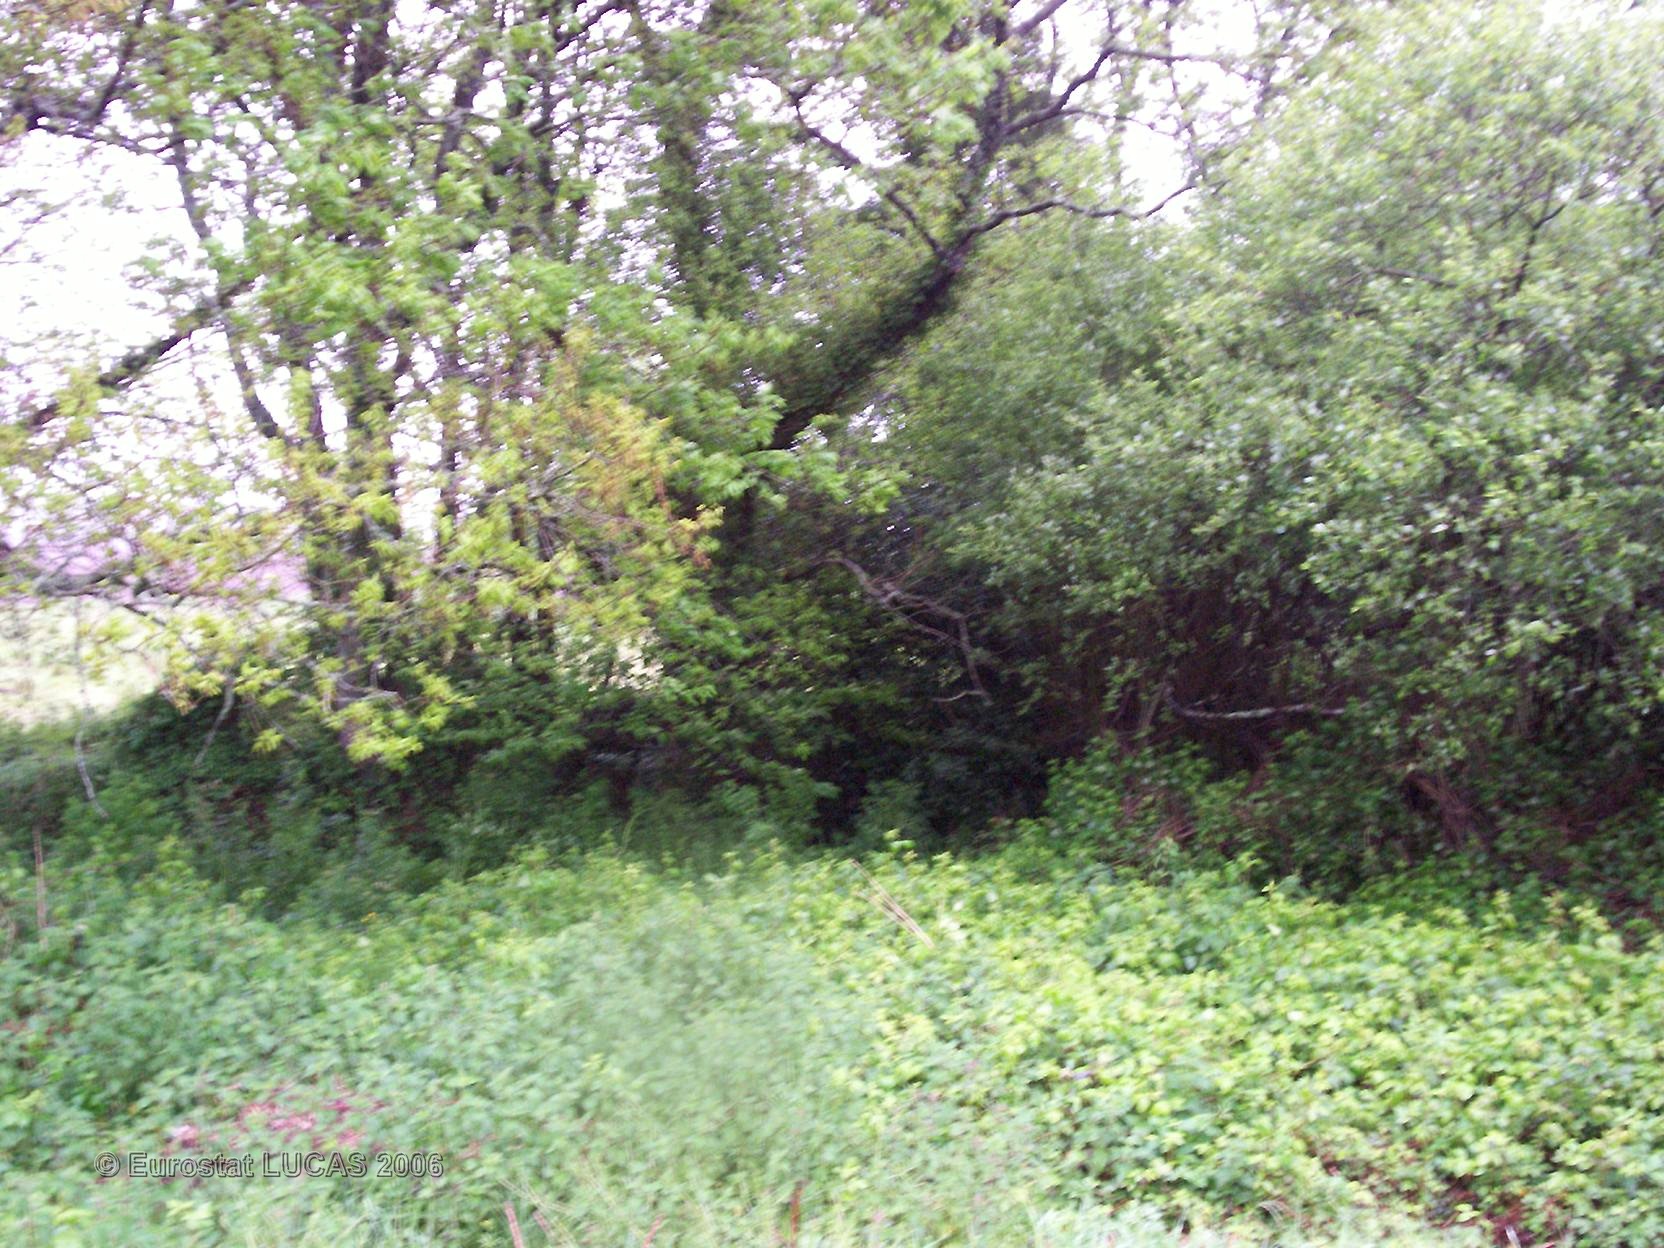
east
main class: Cropland
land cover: Maize
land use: Agriculture (excluding fallow land and kitchen gardens)
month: May
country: FR
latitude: 47.9099
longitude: -3.8501
